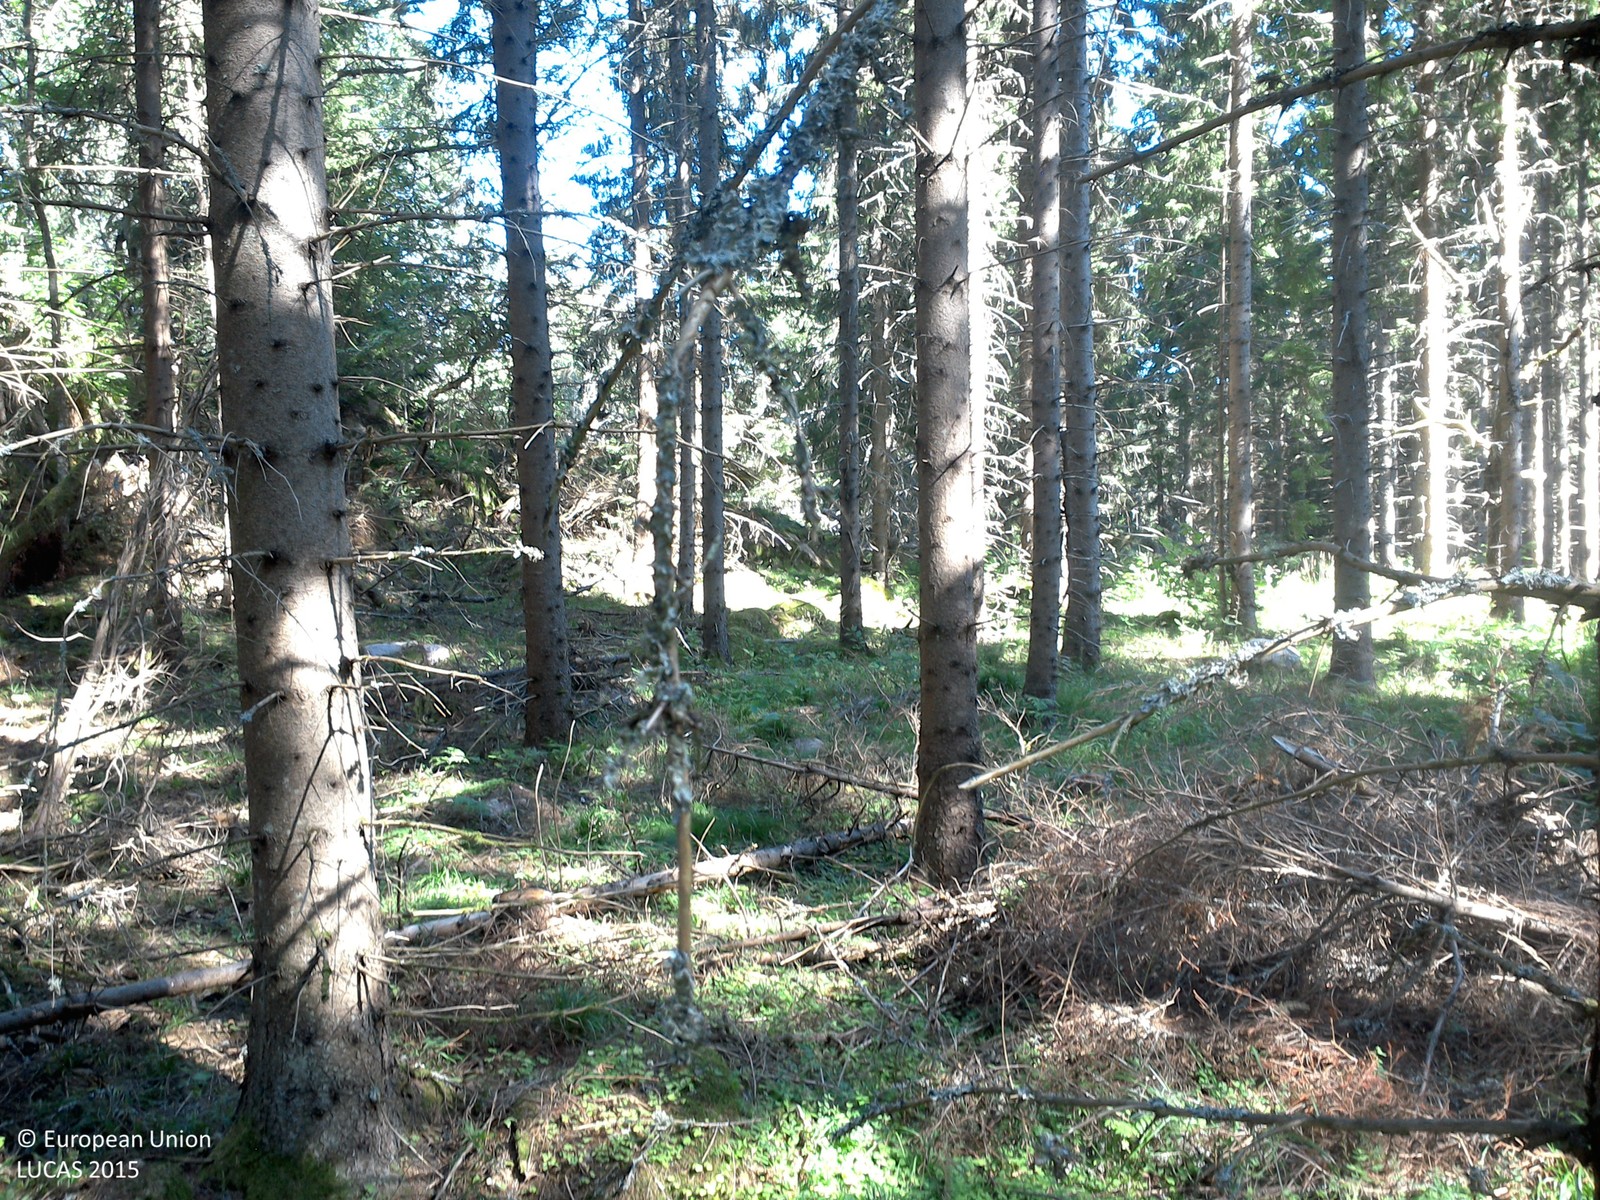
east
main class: Woodland
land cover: Spruce dominated coniferous woodland
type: boreal forest
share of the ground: 50 - 75 %
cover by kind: coniferous forest trees 70 %, herbaceous plants 20 %, lichens and mosses 10 %
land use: Forestry
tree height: > 5 m
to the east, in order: Spruce dominated coniferous woodland; Paved roads, cycling and walking lanes; Other bare soil; Spruce dominated coniferous woodland
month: August
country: SE
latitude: 58.1174
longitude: 15.2401
